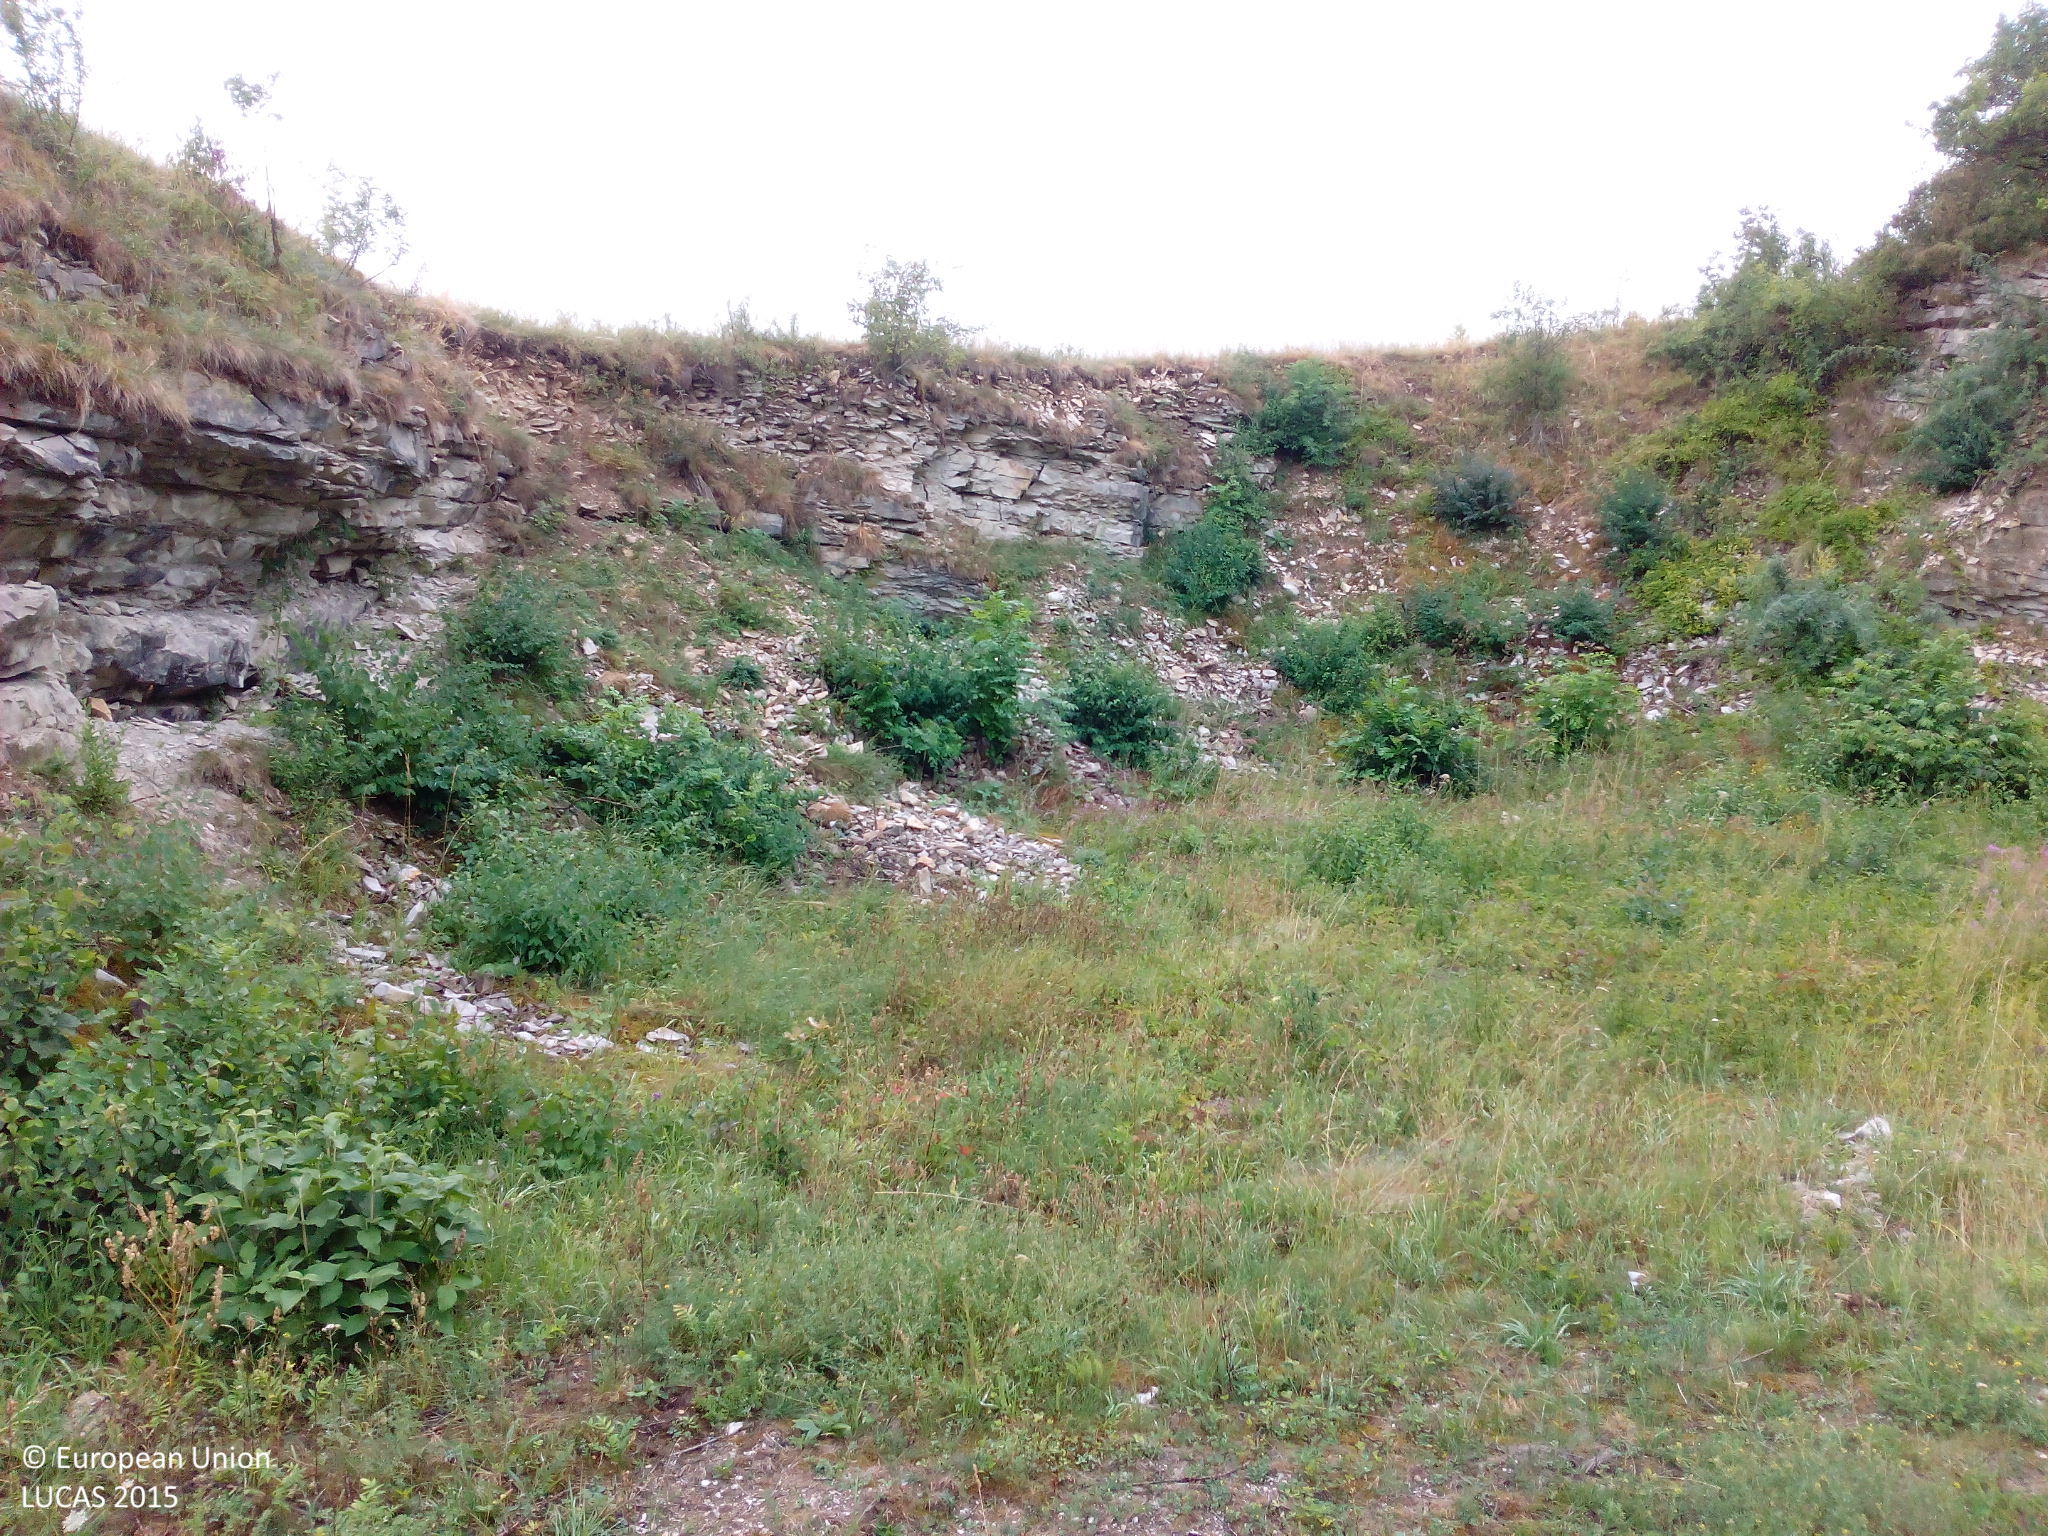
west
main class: Shrubland
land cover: Shrubland with sparse tree cover
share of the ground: > 75 %
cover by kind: herbaceous plants 60 %, shrubs 30 %, broadleaved forest trees 5 %, unconsolidated bare surface 5 %
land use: Semi-natural and natural areas not in use
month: July
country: DE
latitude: 48.8710
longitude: 10.2589
